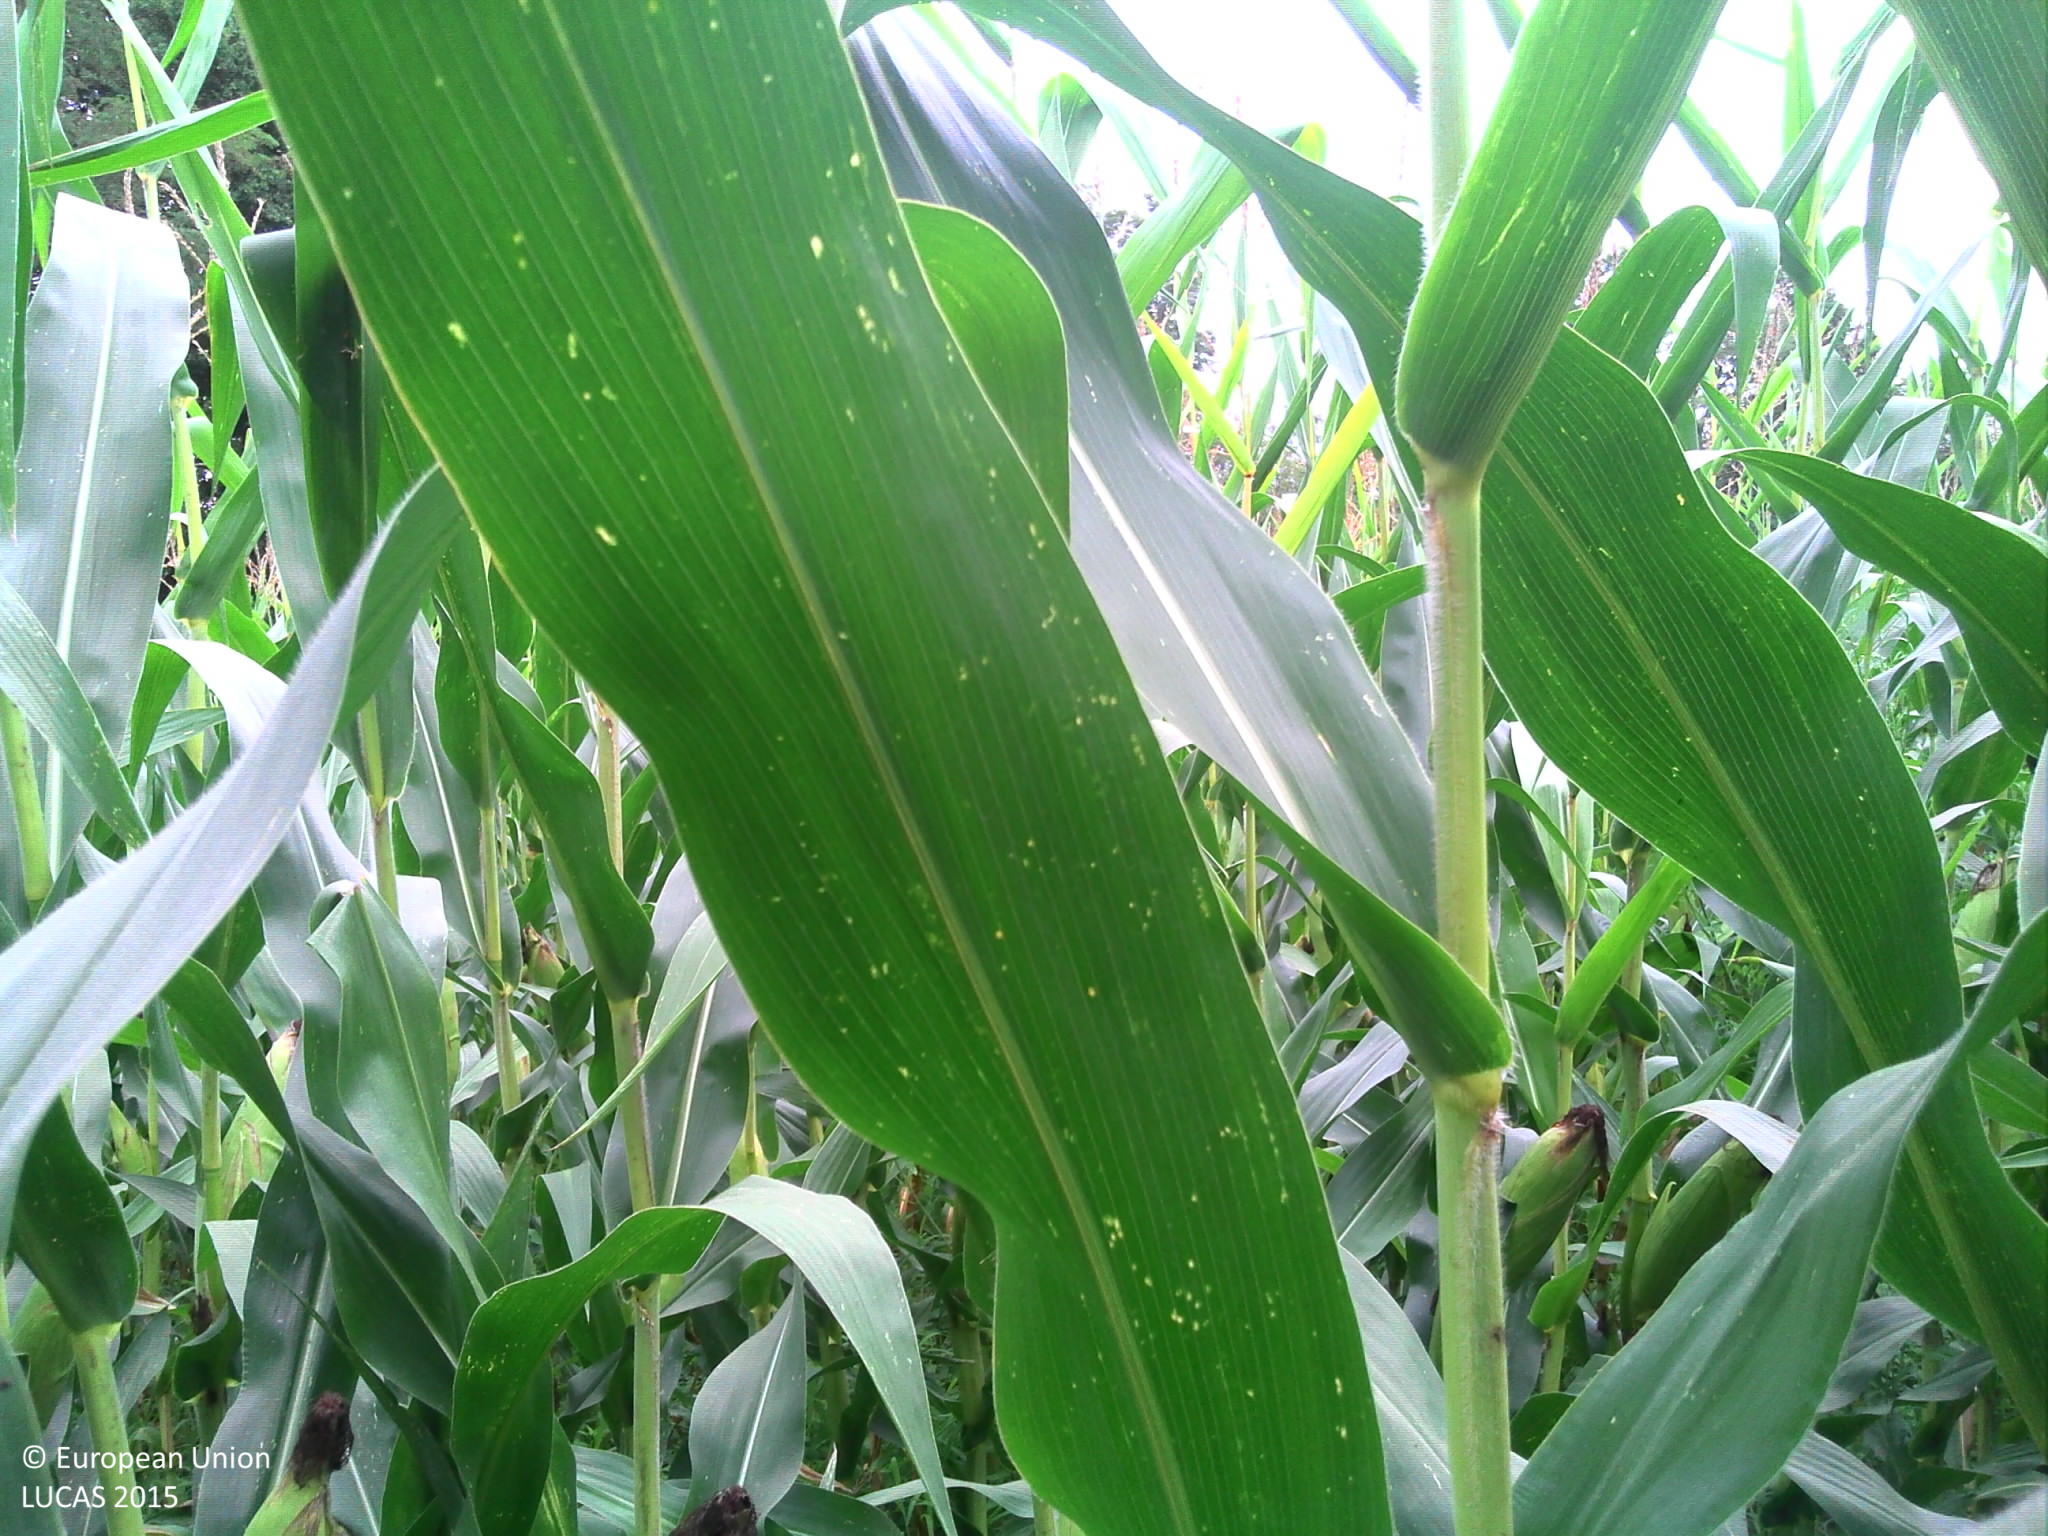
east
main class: Cropland
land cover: Maize
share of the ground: > 75 %
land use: Agriculture (excluding fallow land and kitchen gardens)
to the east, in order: Maize; Grass margins; Shrubland with sparse tree cover; Rivers and streams; Broadleaved woodland; Grass margins; Tracks; Grass margins; Ditches and canals; Other bare soil
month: August
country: FR
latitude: 43.5127
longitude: -1.1357
